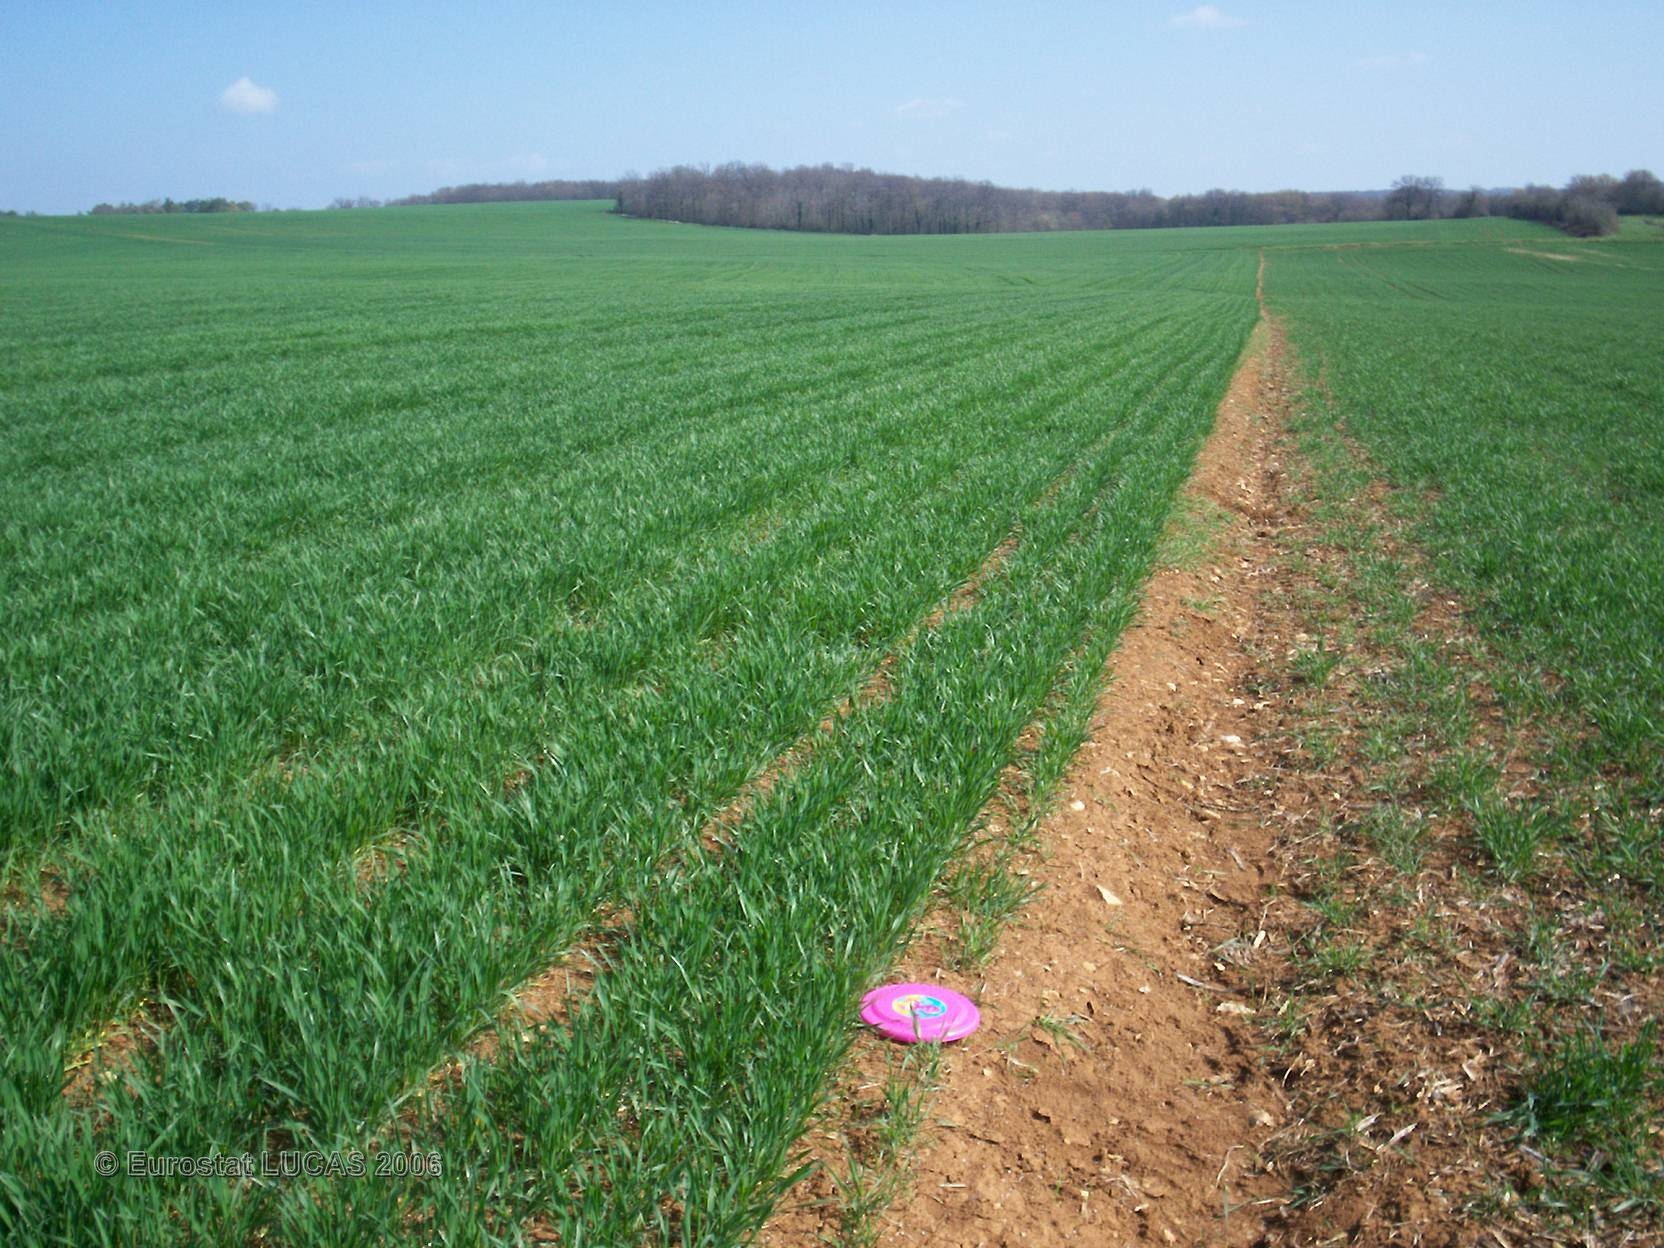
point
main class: Cropland
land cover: Common wheat
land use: Agriculture (excluding fallow land and kitchen gardens)
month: April
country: FR
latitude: 47.4394
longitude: 4.5495
